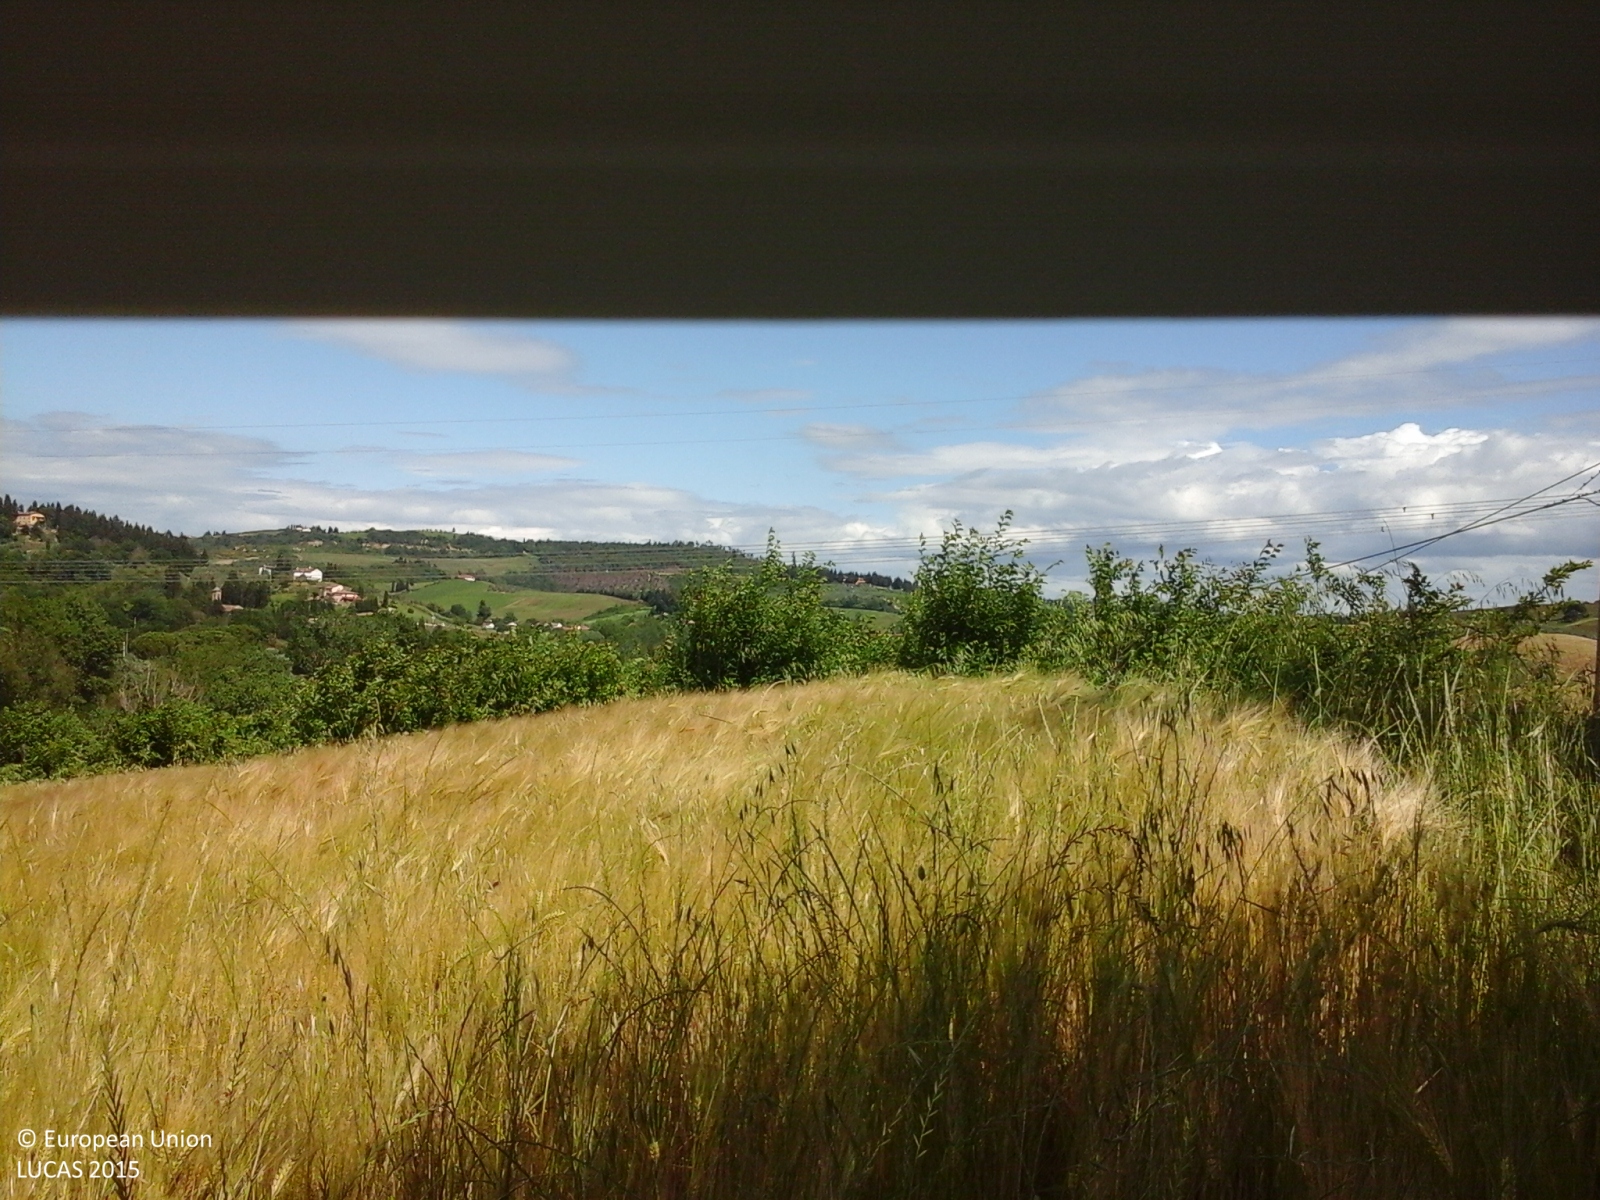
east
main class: Cropland
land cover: Durum wheat
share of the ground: > 75 %
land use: Agriculture (excluding fallow land and kitchen gardens)
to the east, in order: Durum wheat; Grass margins; Tracks; Broadleaved woodland; Electric lines; Ditches and canals; Broadleaved woodland
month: May
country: IT
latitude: 43.6784
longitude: 10.9773
